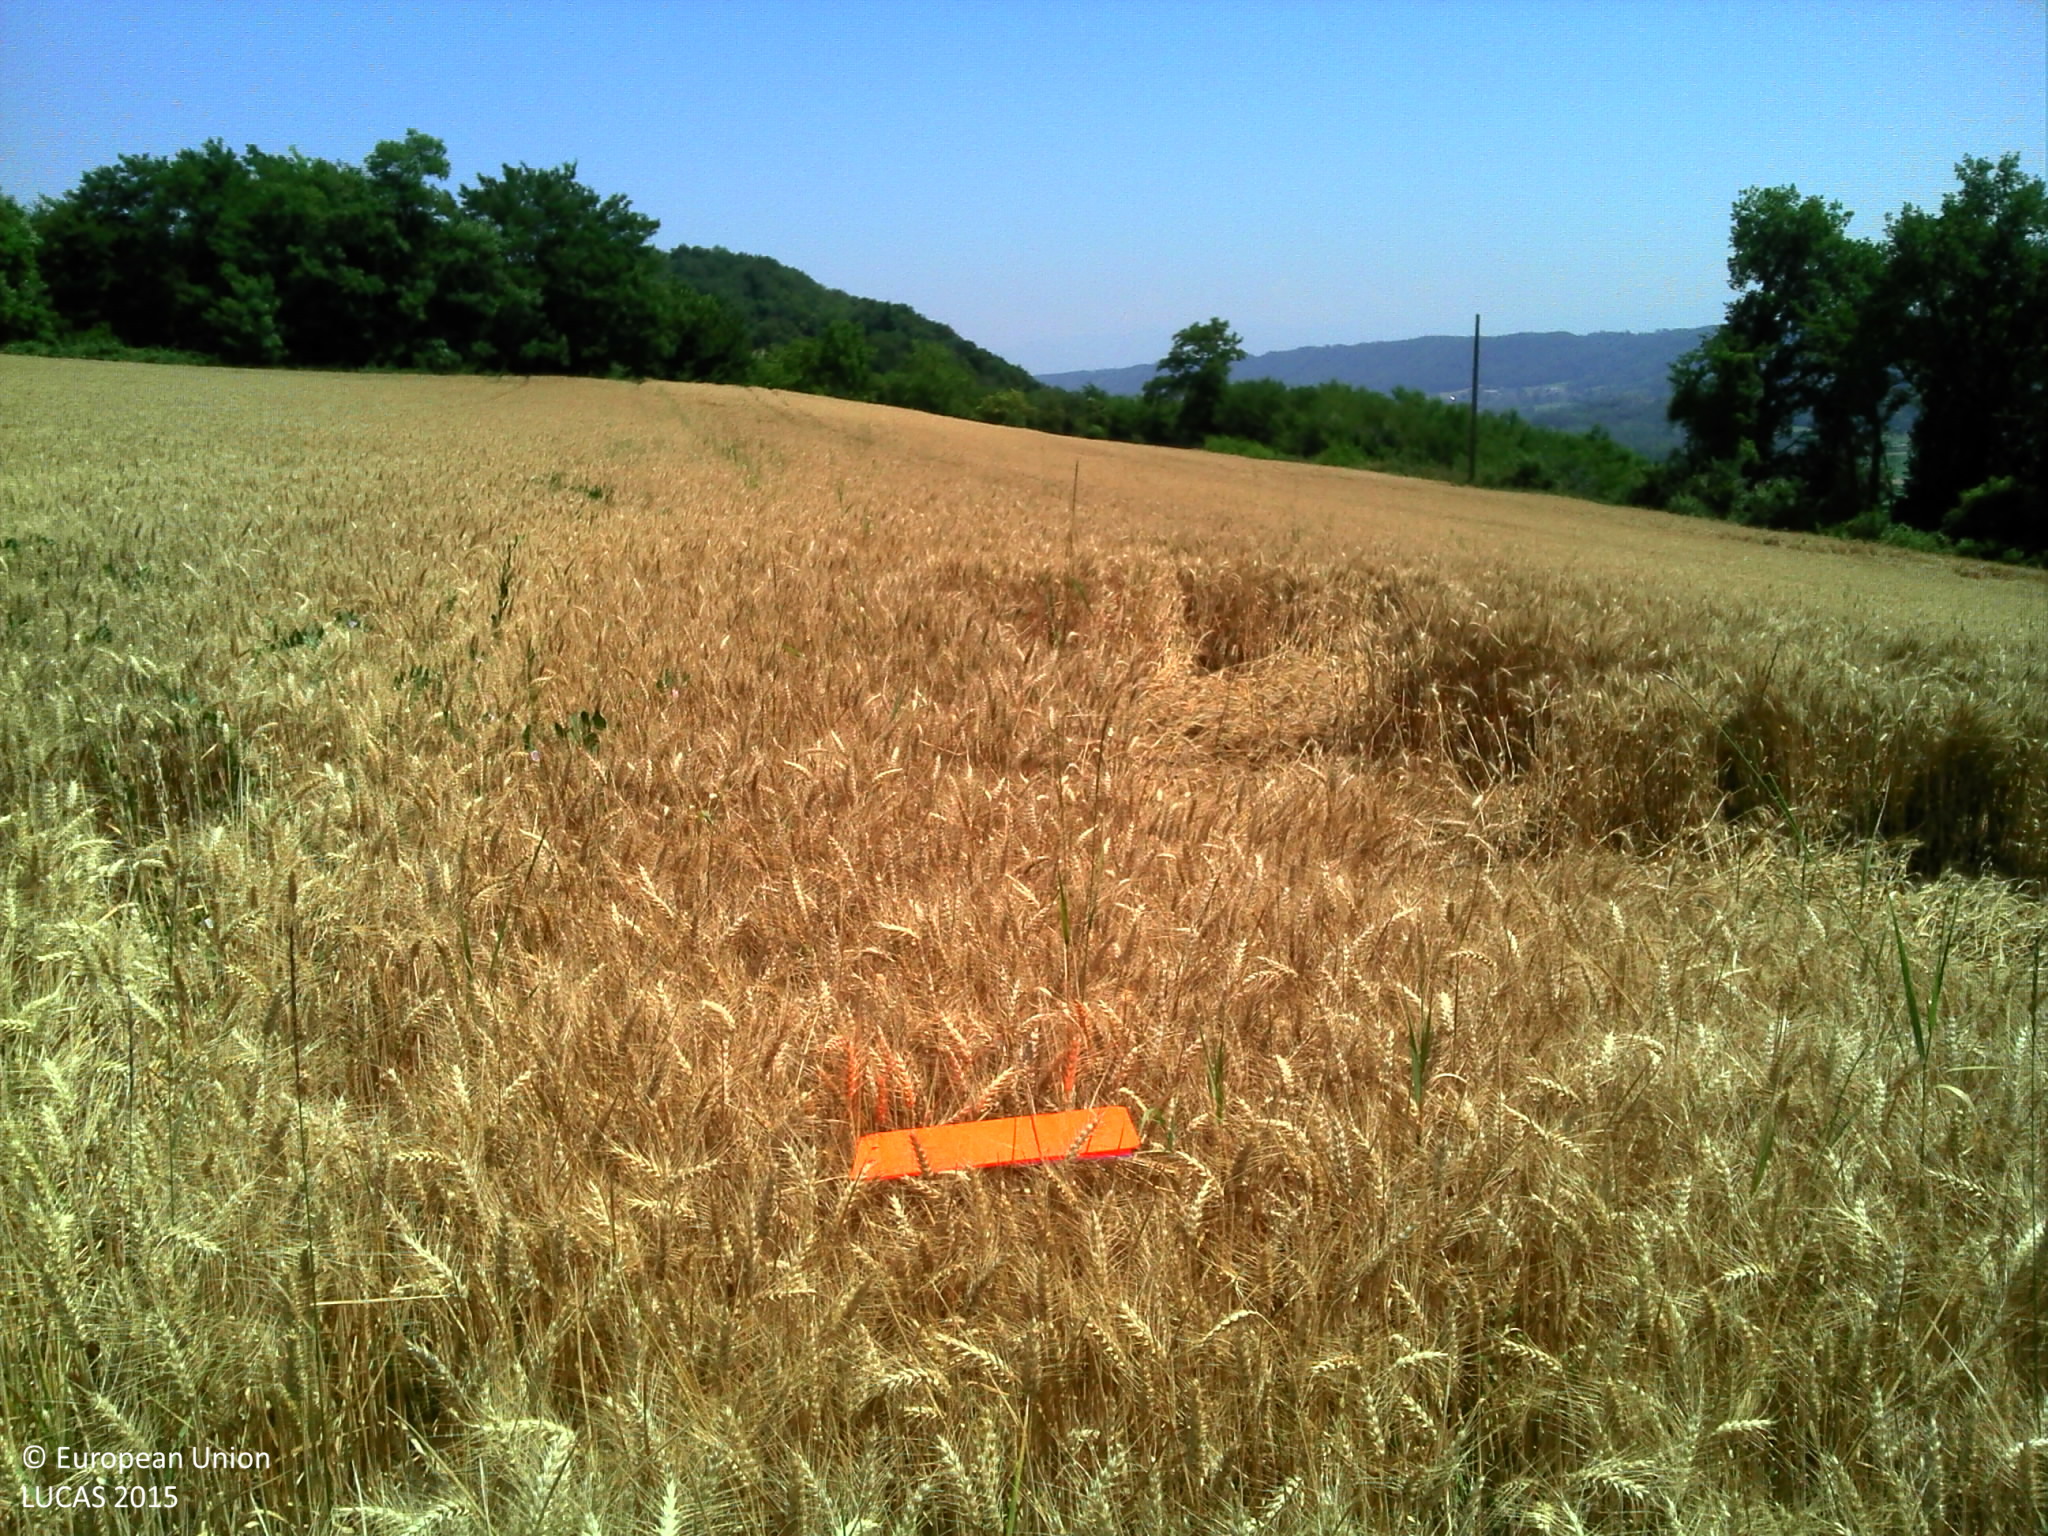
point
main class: Cropland
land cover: Durum wheat
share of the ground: > 75 %
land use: Agriculture (excluding fallow land and kitchen gardens)
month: July
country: FR
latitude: 45.6556
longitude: 5.3715
